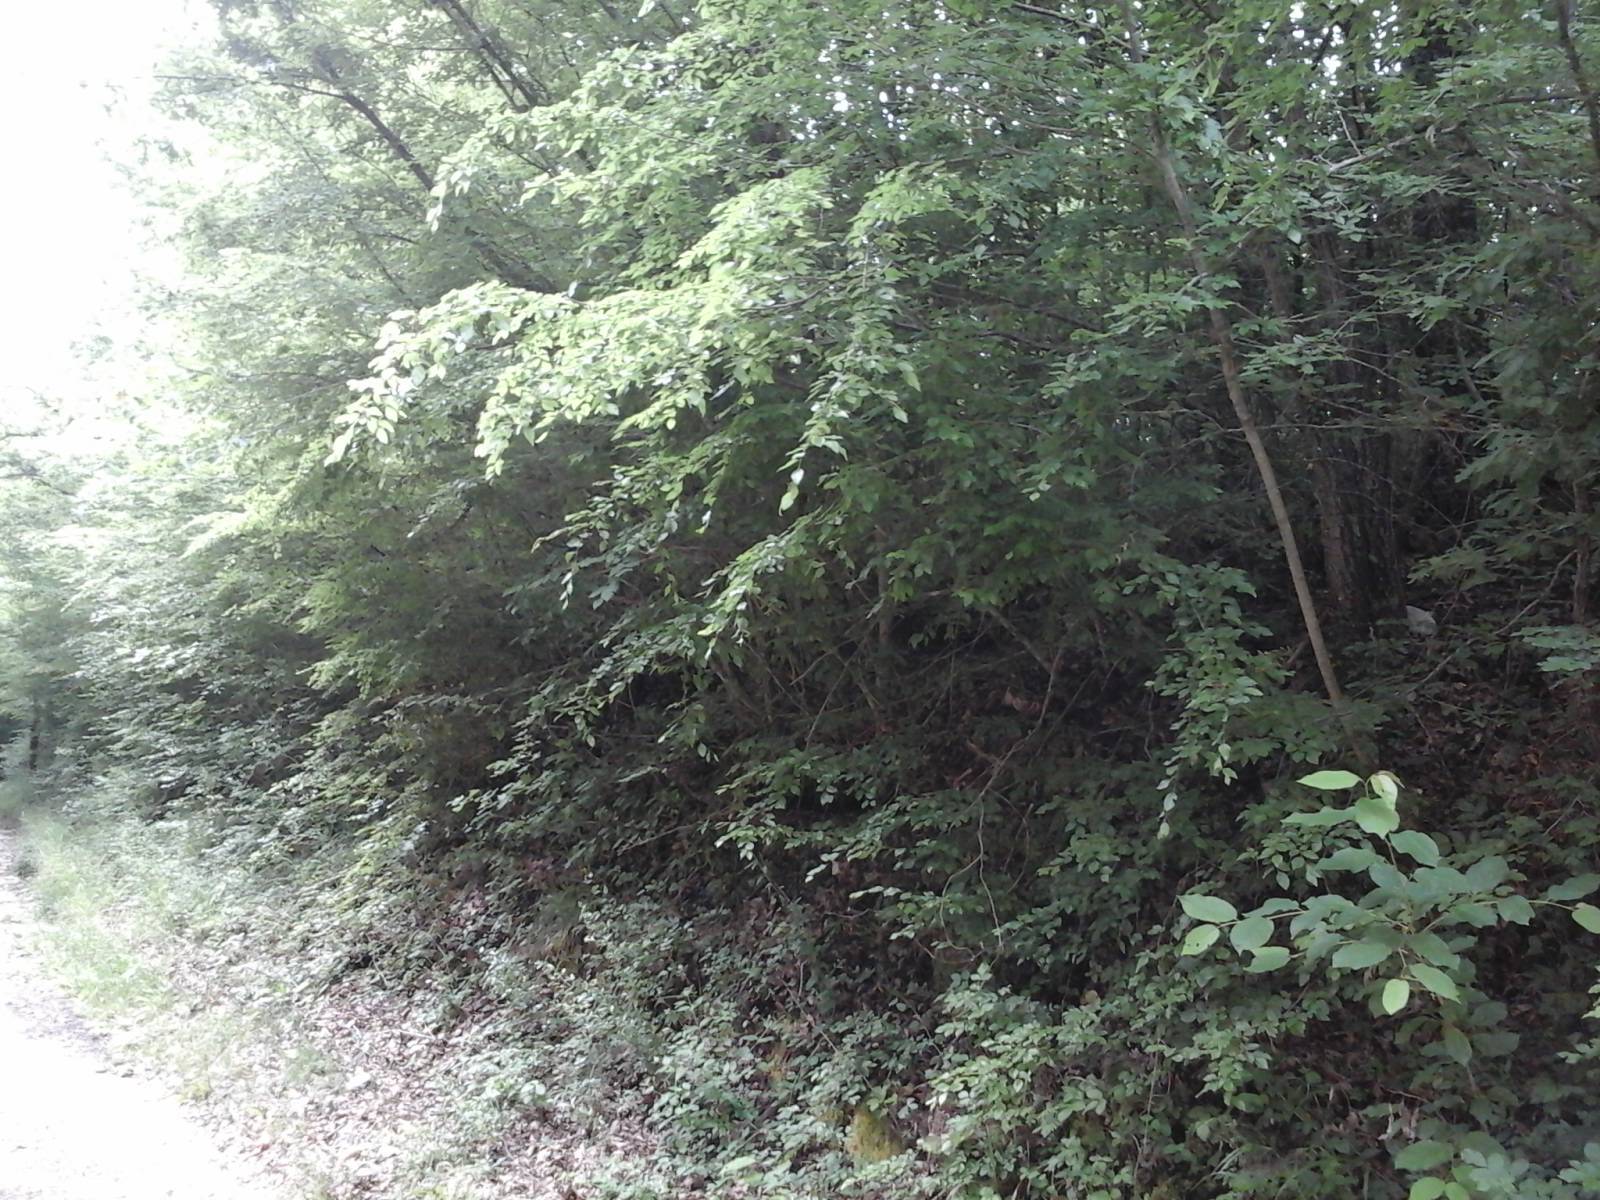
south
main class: Woodland
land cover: Broadleaved woodland
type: thermophilous deciduous forest
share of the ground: > 75 %
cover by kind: broadleaved forest trees 100 %
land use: Forestry
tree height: < 5 m
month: May
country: IT
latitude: 41.2432
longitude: 14.2673
